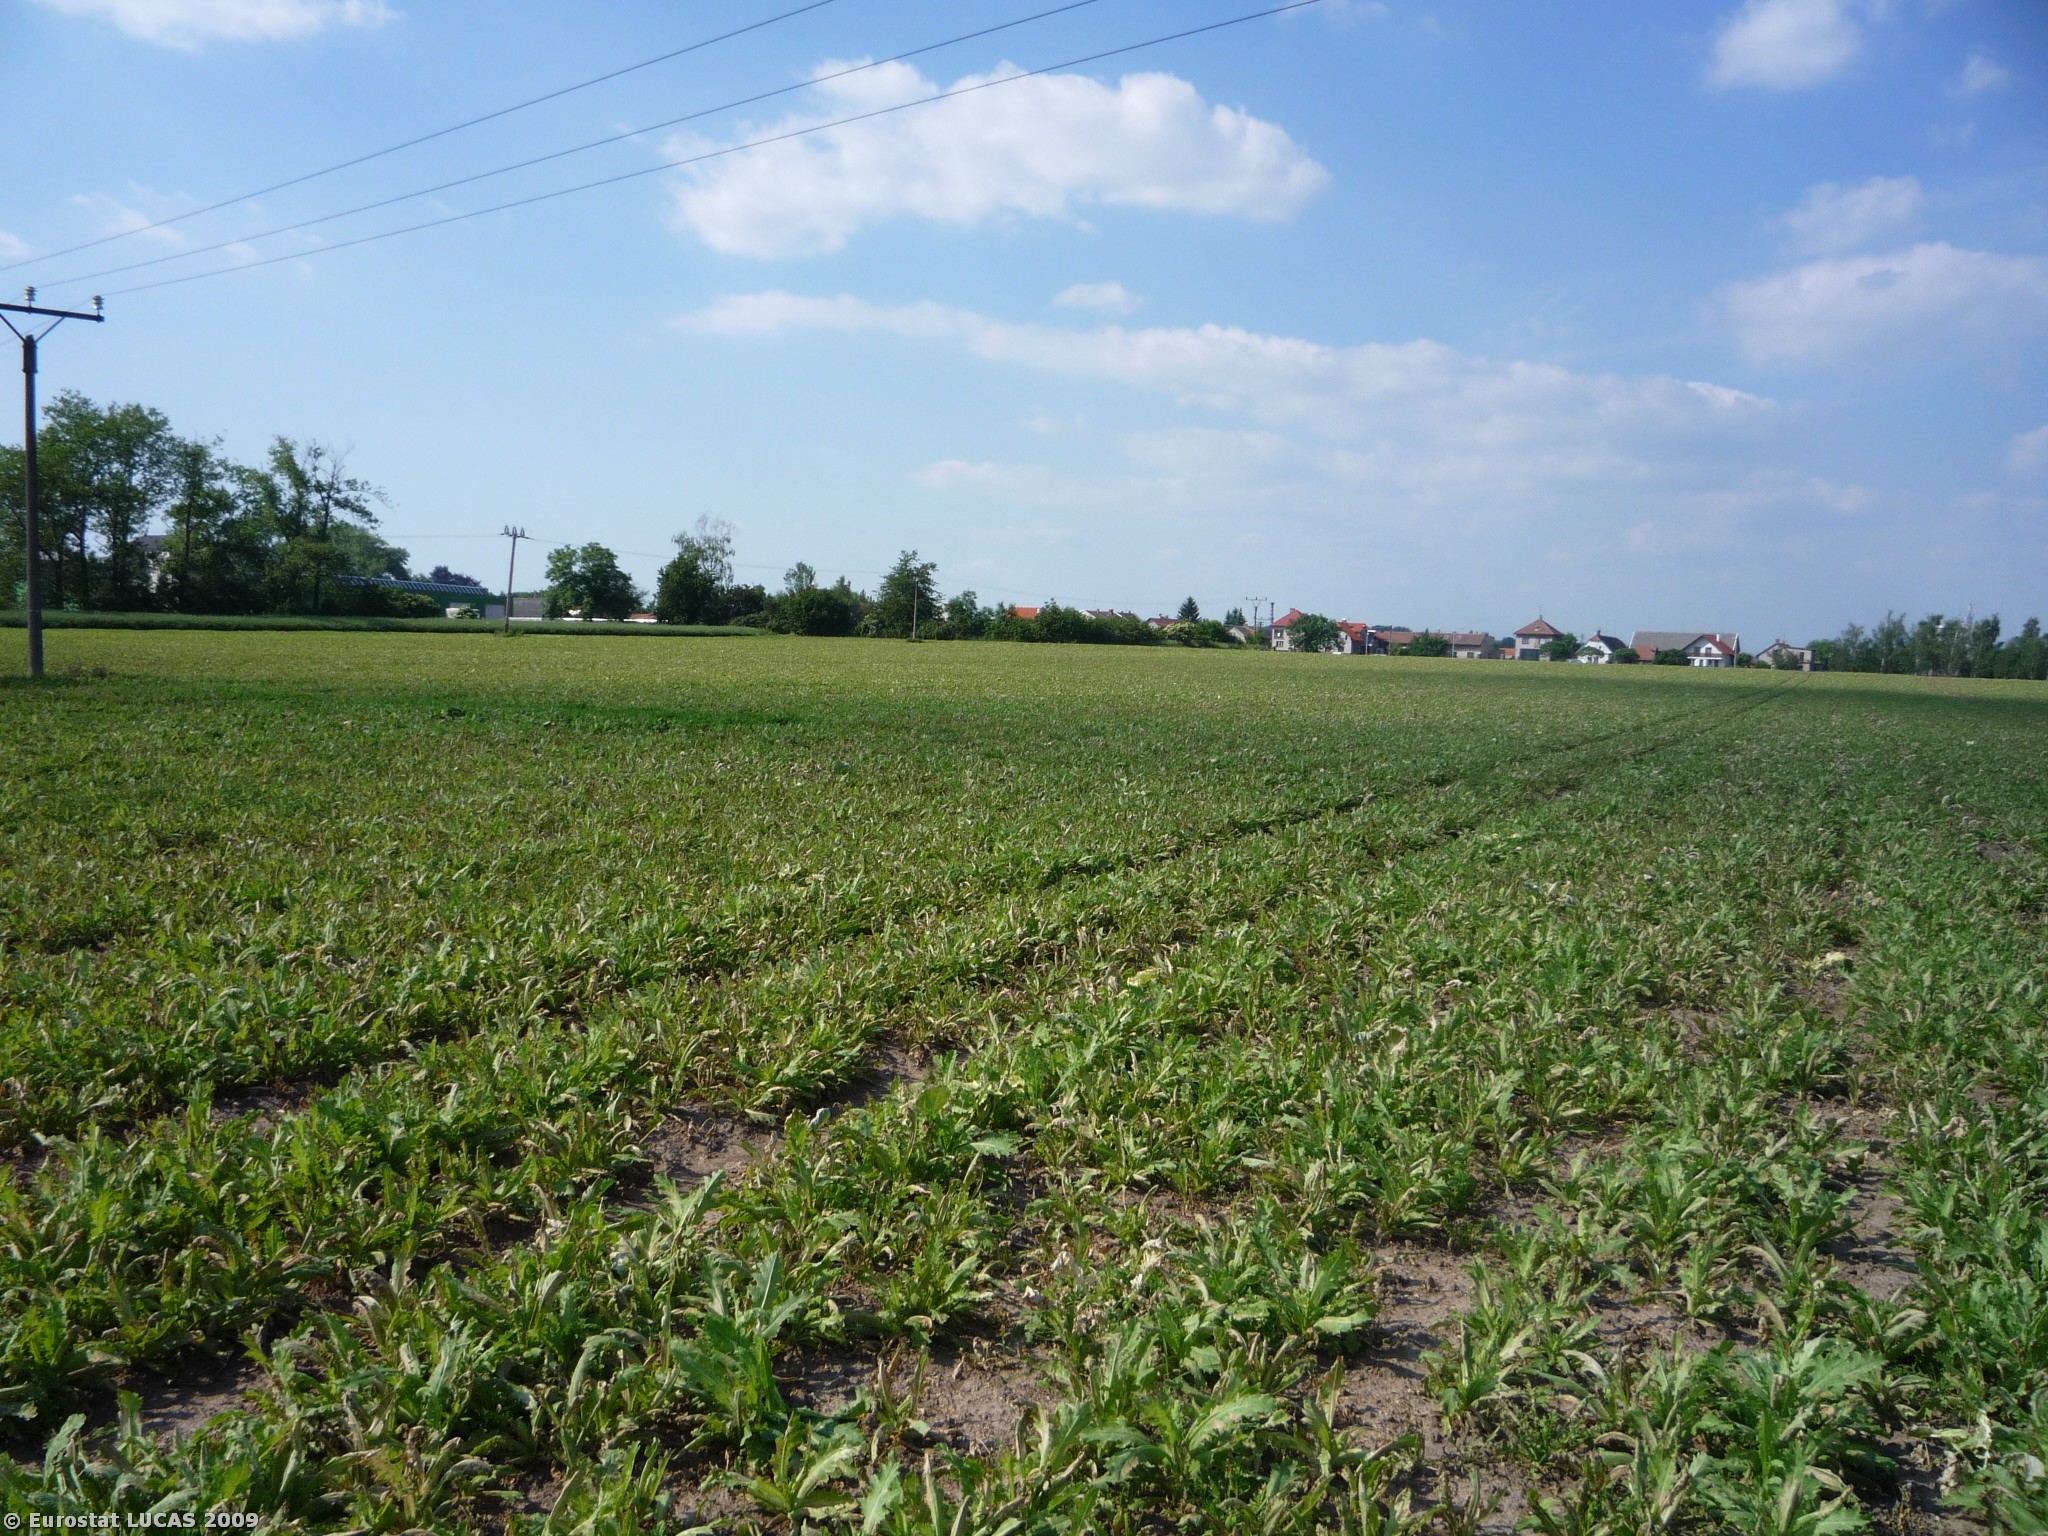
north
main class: Cropland
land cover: Other fibre and oleaginous crops
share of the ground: > 75 %
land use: Agriculture (excluding fallow land and kitchen gardens)
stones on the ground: < 10 %
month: May
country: CZ
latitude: 50.2173
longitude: 15.7930
